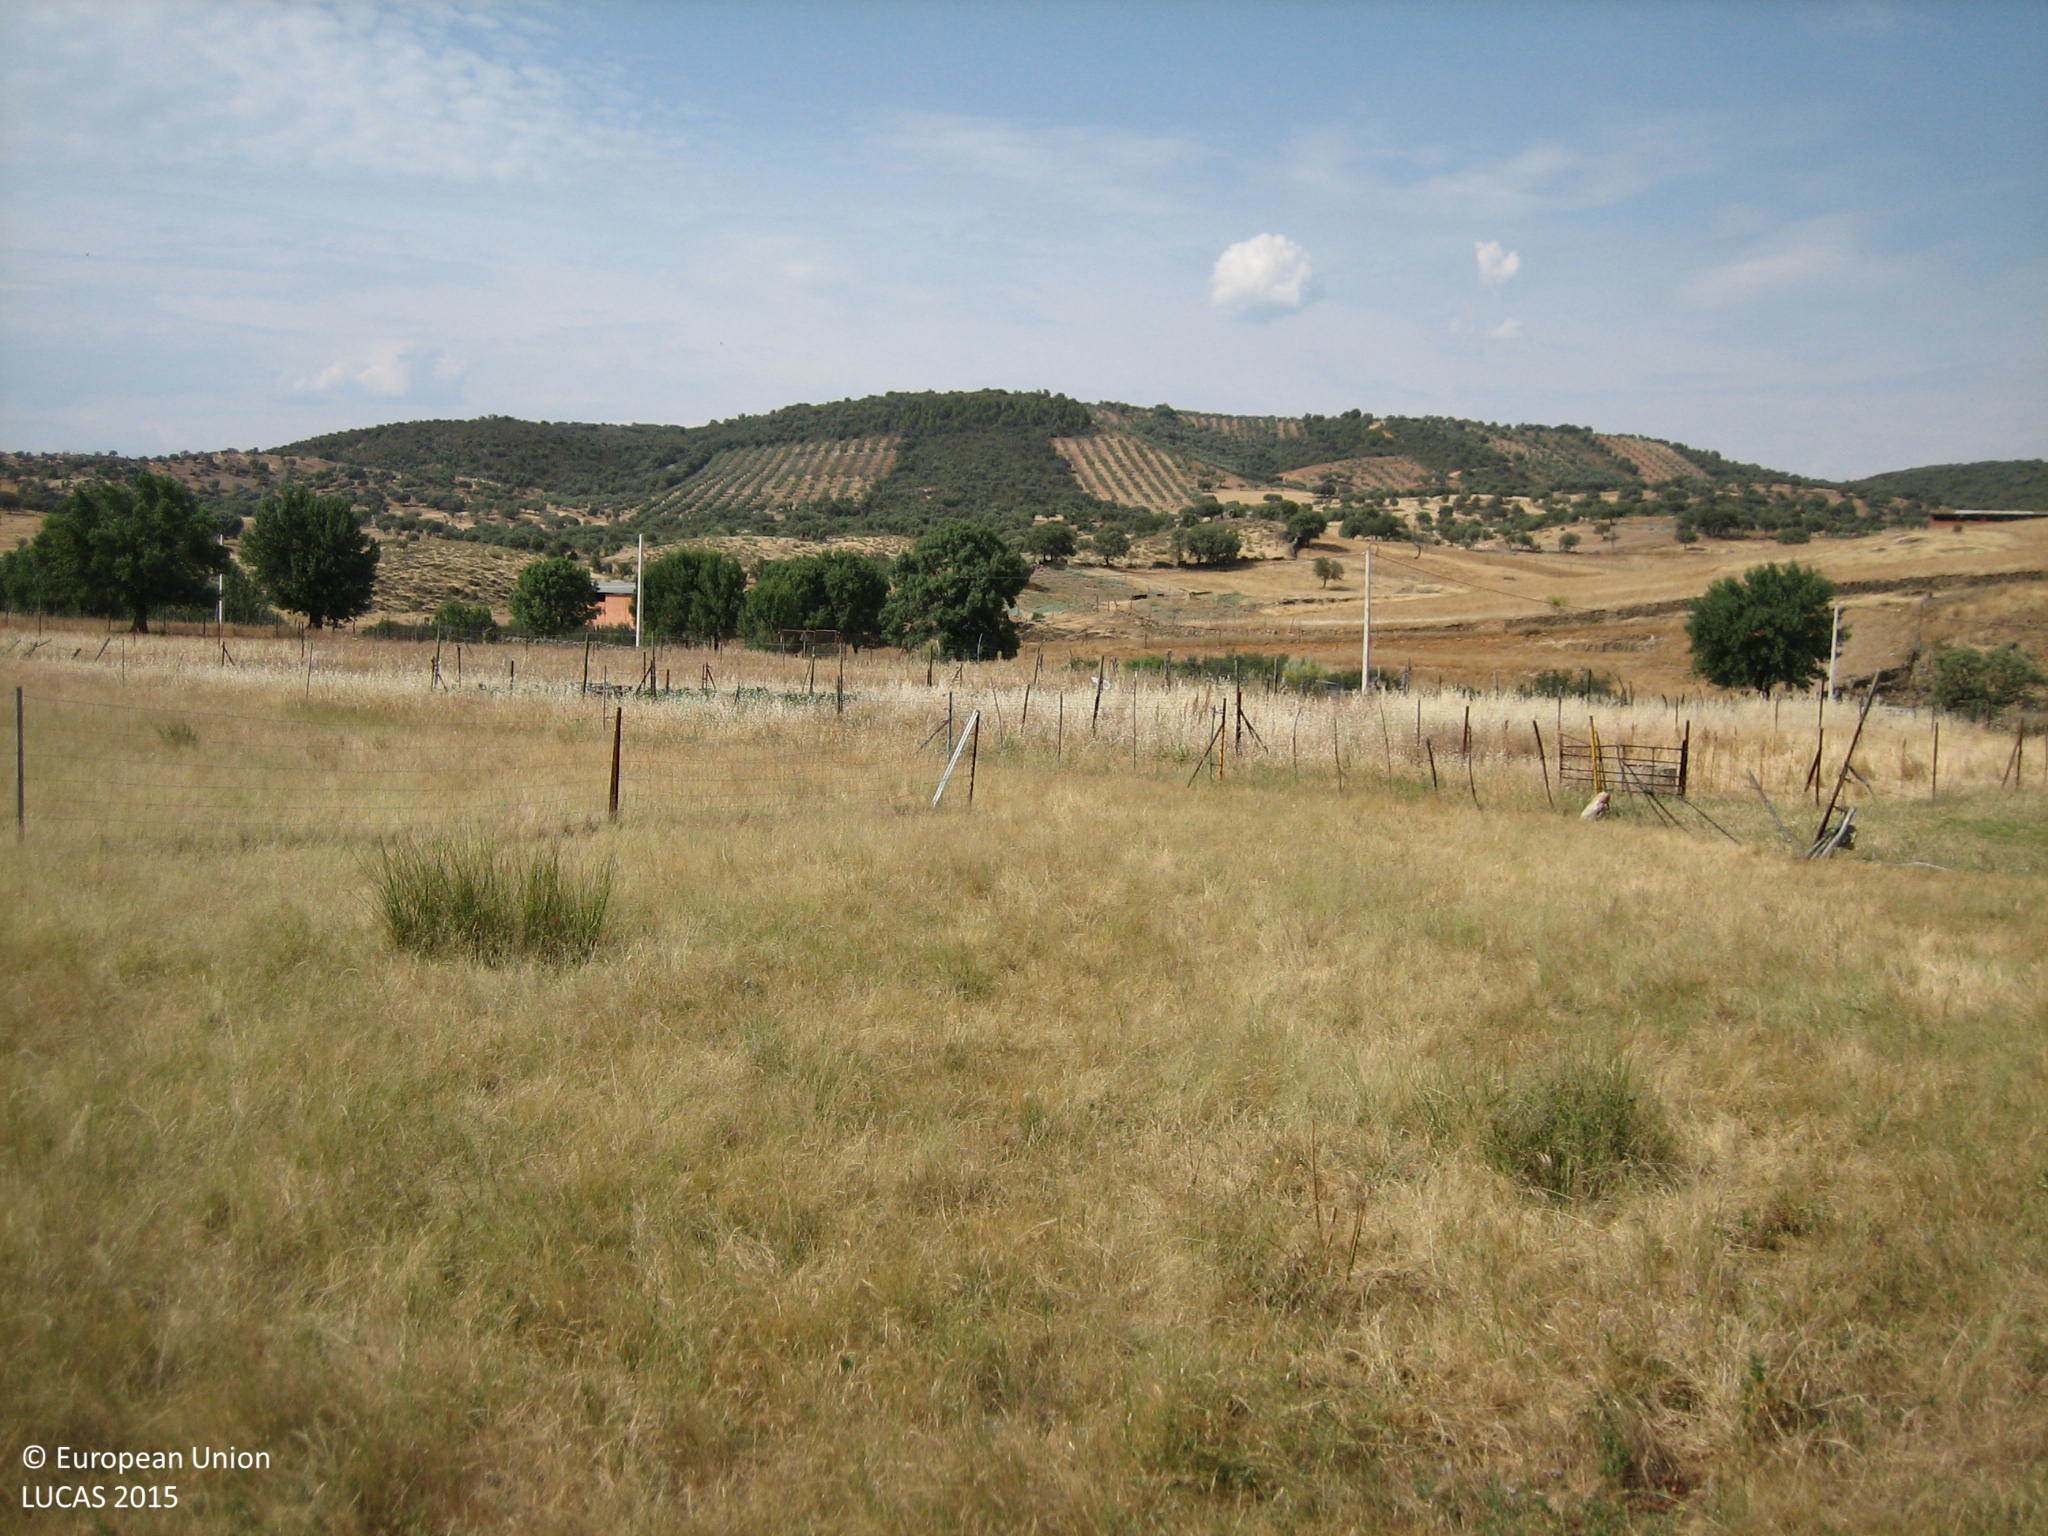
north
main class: Grassland
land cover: Spontaneously vegetated surfaces
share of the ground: > 75 %
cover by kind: herbaceous plants 100 %
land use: Fallow land
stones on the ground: < 10 %
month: June
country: ES
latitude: 39.3245
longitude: -4.7808
